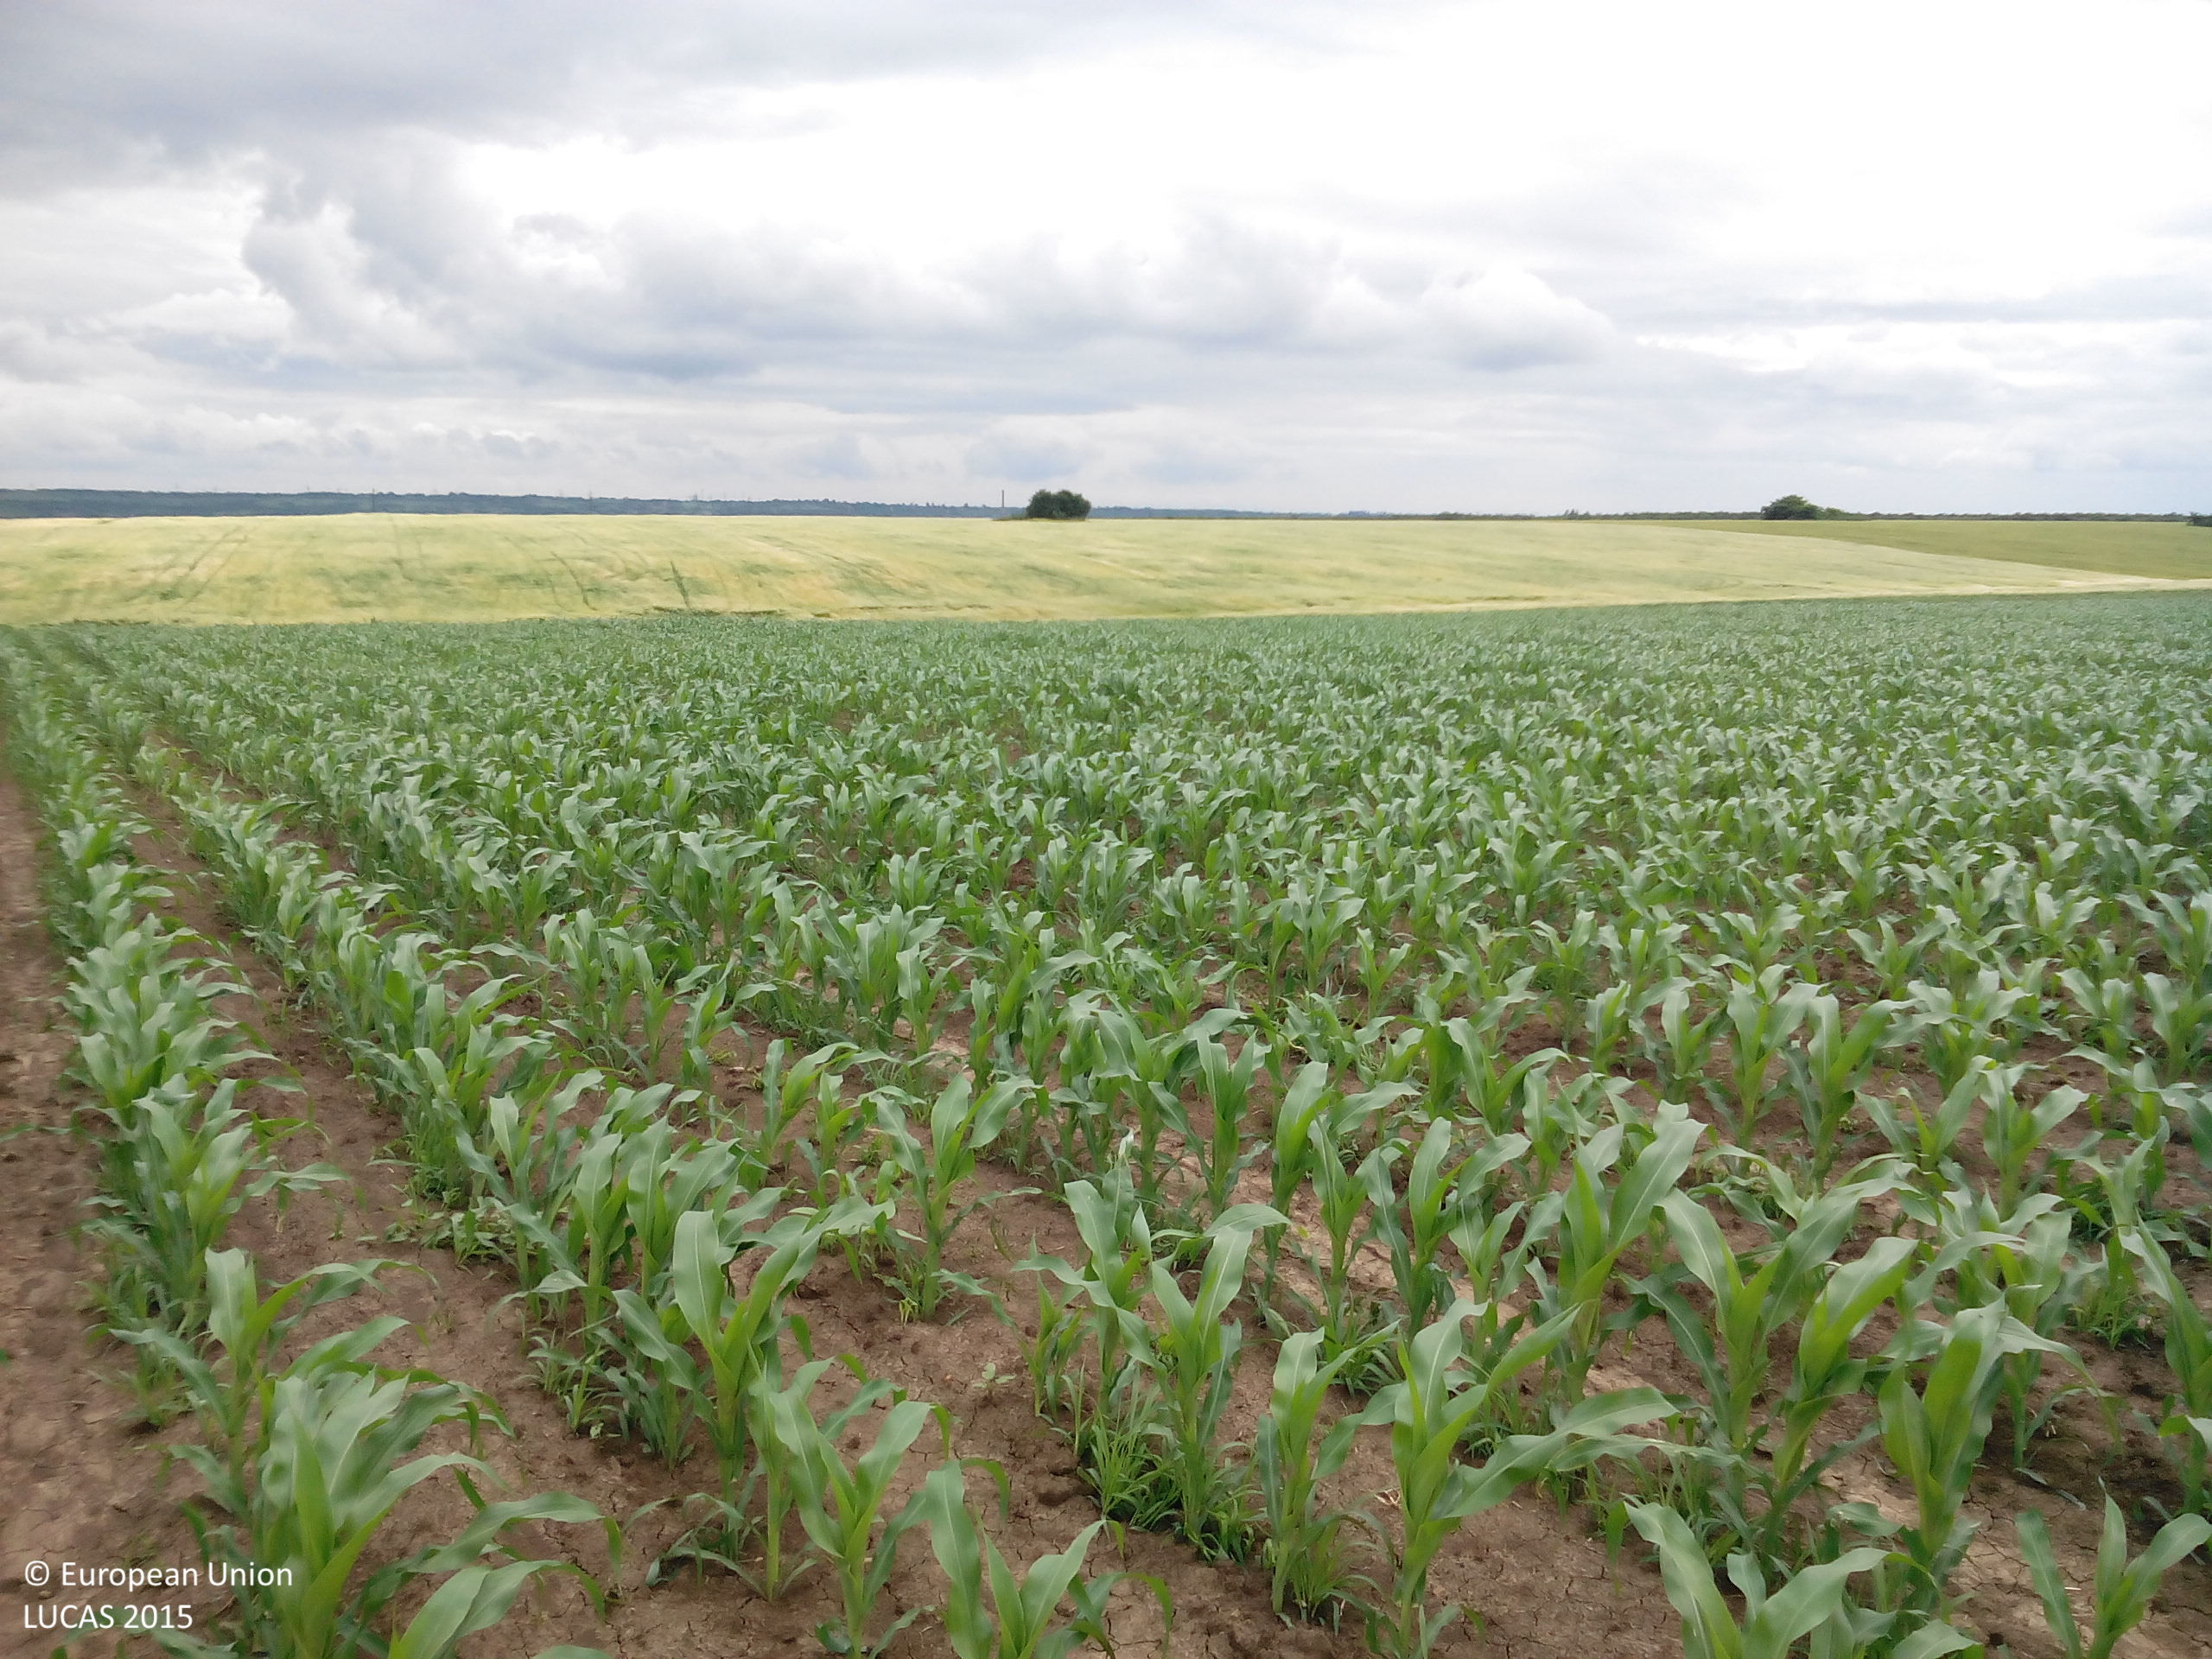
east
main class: Cropland
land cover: Maize
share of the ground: 50 - 75 %
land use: Agriculture (excluding fallow land and kitchen gardens)
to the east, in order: Maize; Grass margins; Tracks; Barley
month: May
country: BG
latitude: 43.4848
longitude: 23.8864
